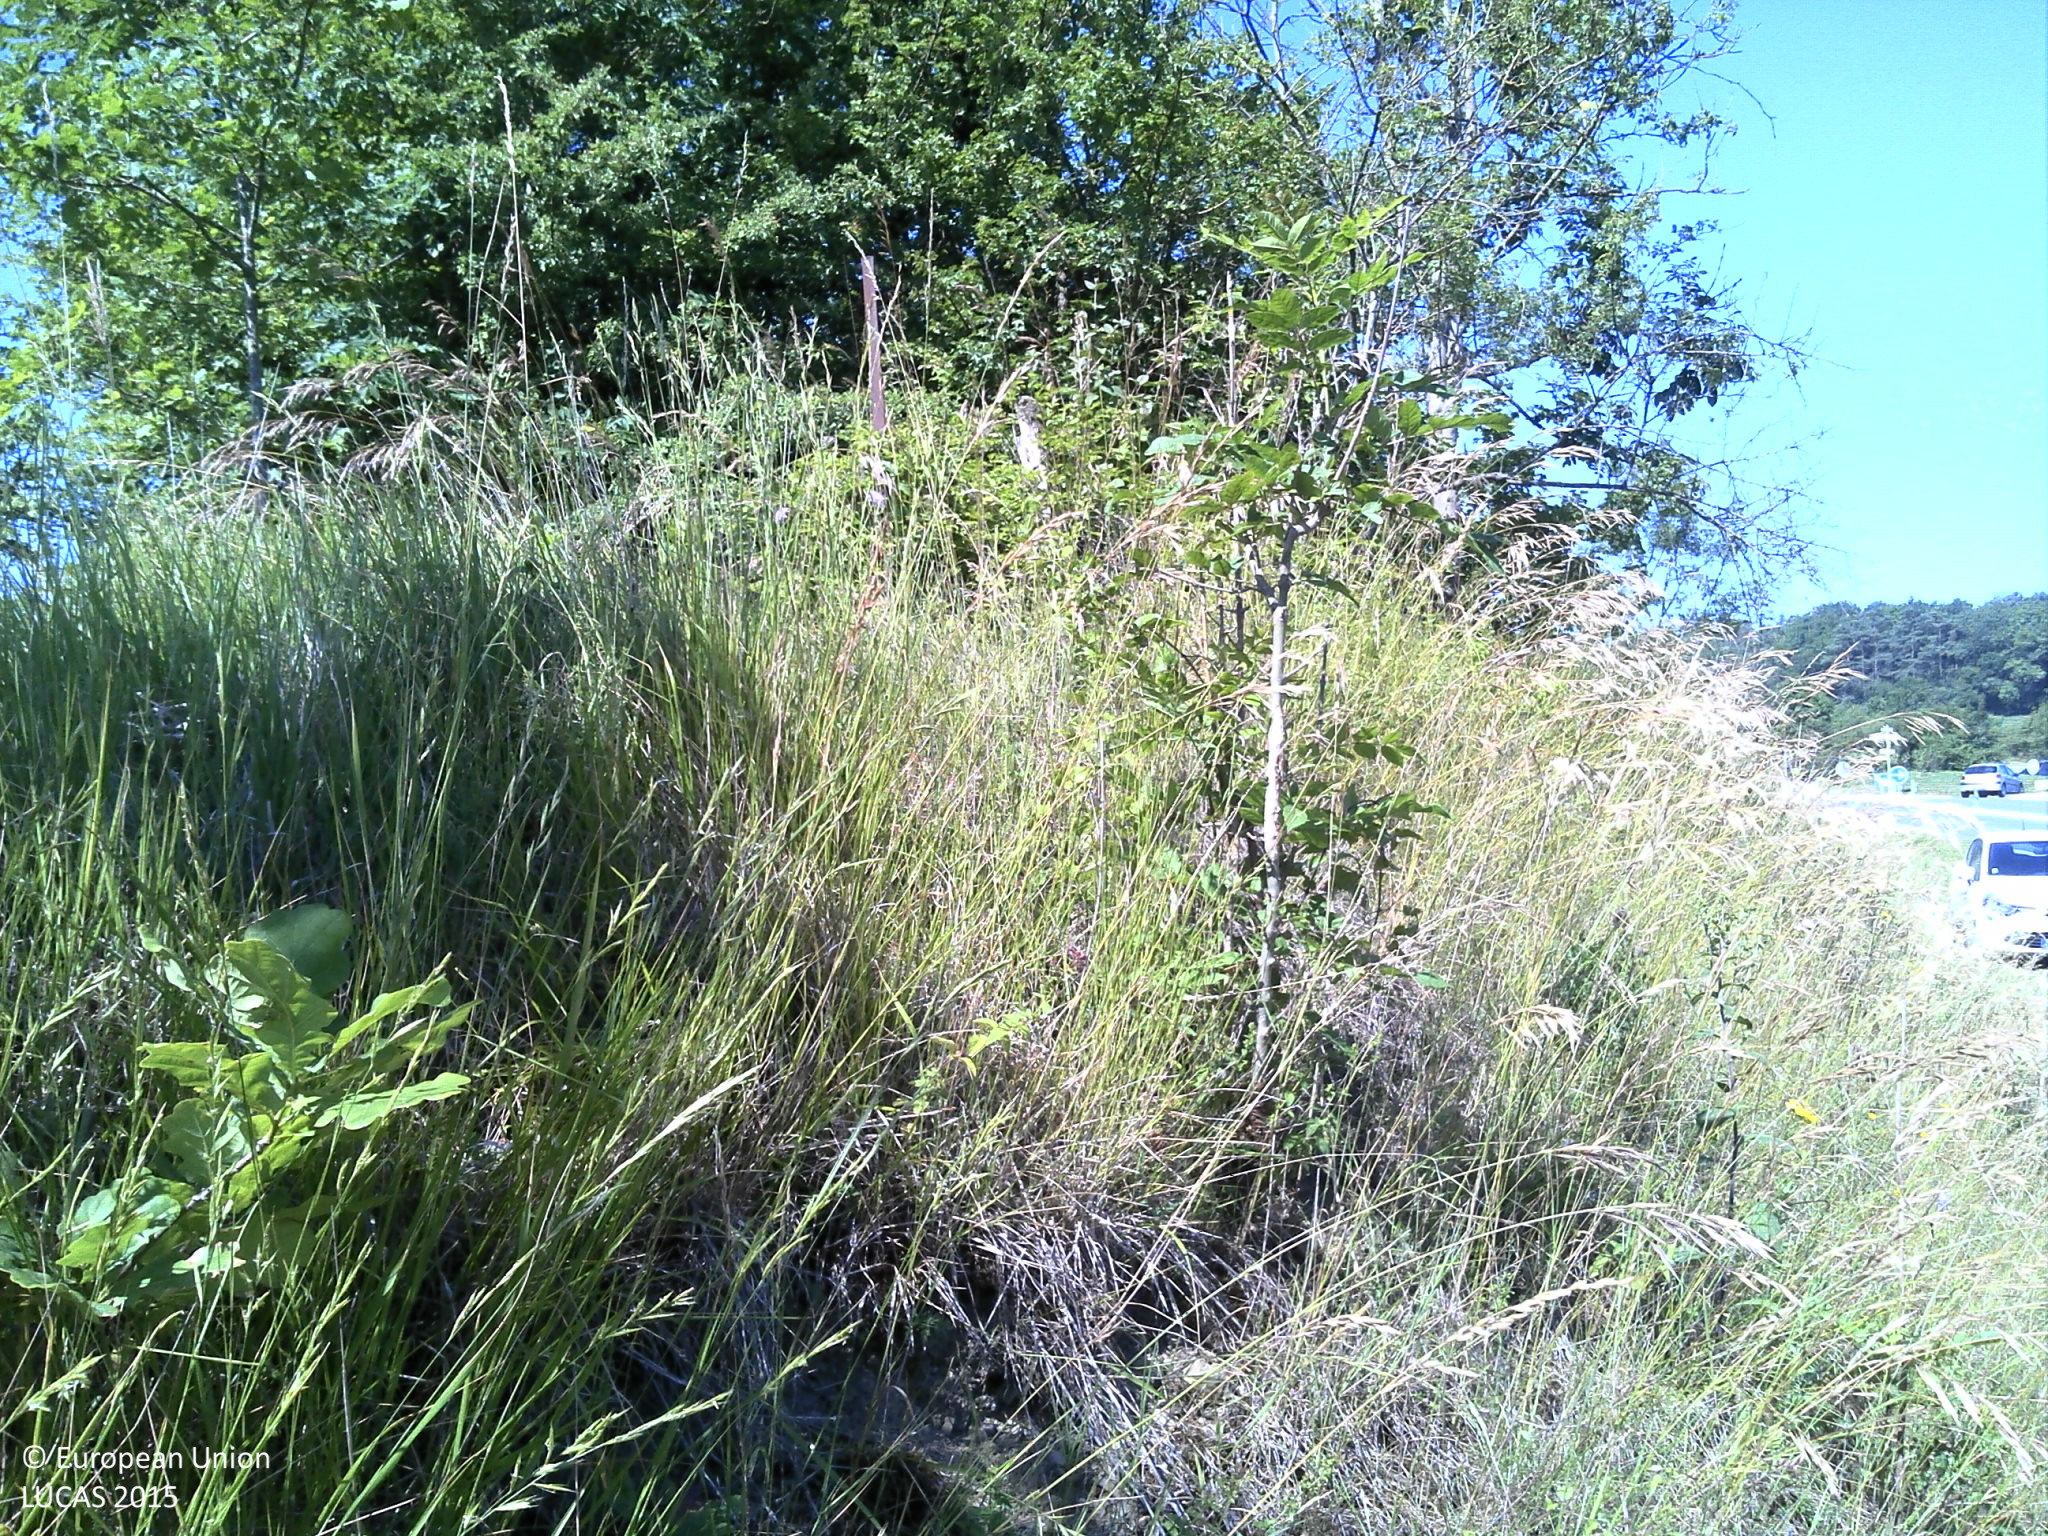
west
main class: Grassland
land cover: Grassland with sparse tree/shrub cover
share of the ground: > 75 %
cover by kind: herbaceous plants 95 %, broadleaved forest trees 5 %
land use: Semi-natural and natural areas not in use
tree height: < 5 m
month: June
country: FR
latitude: 50.1188
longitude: 4.7800
